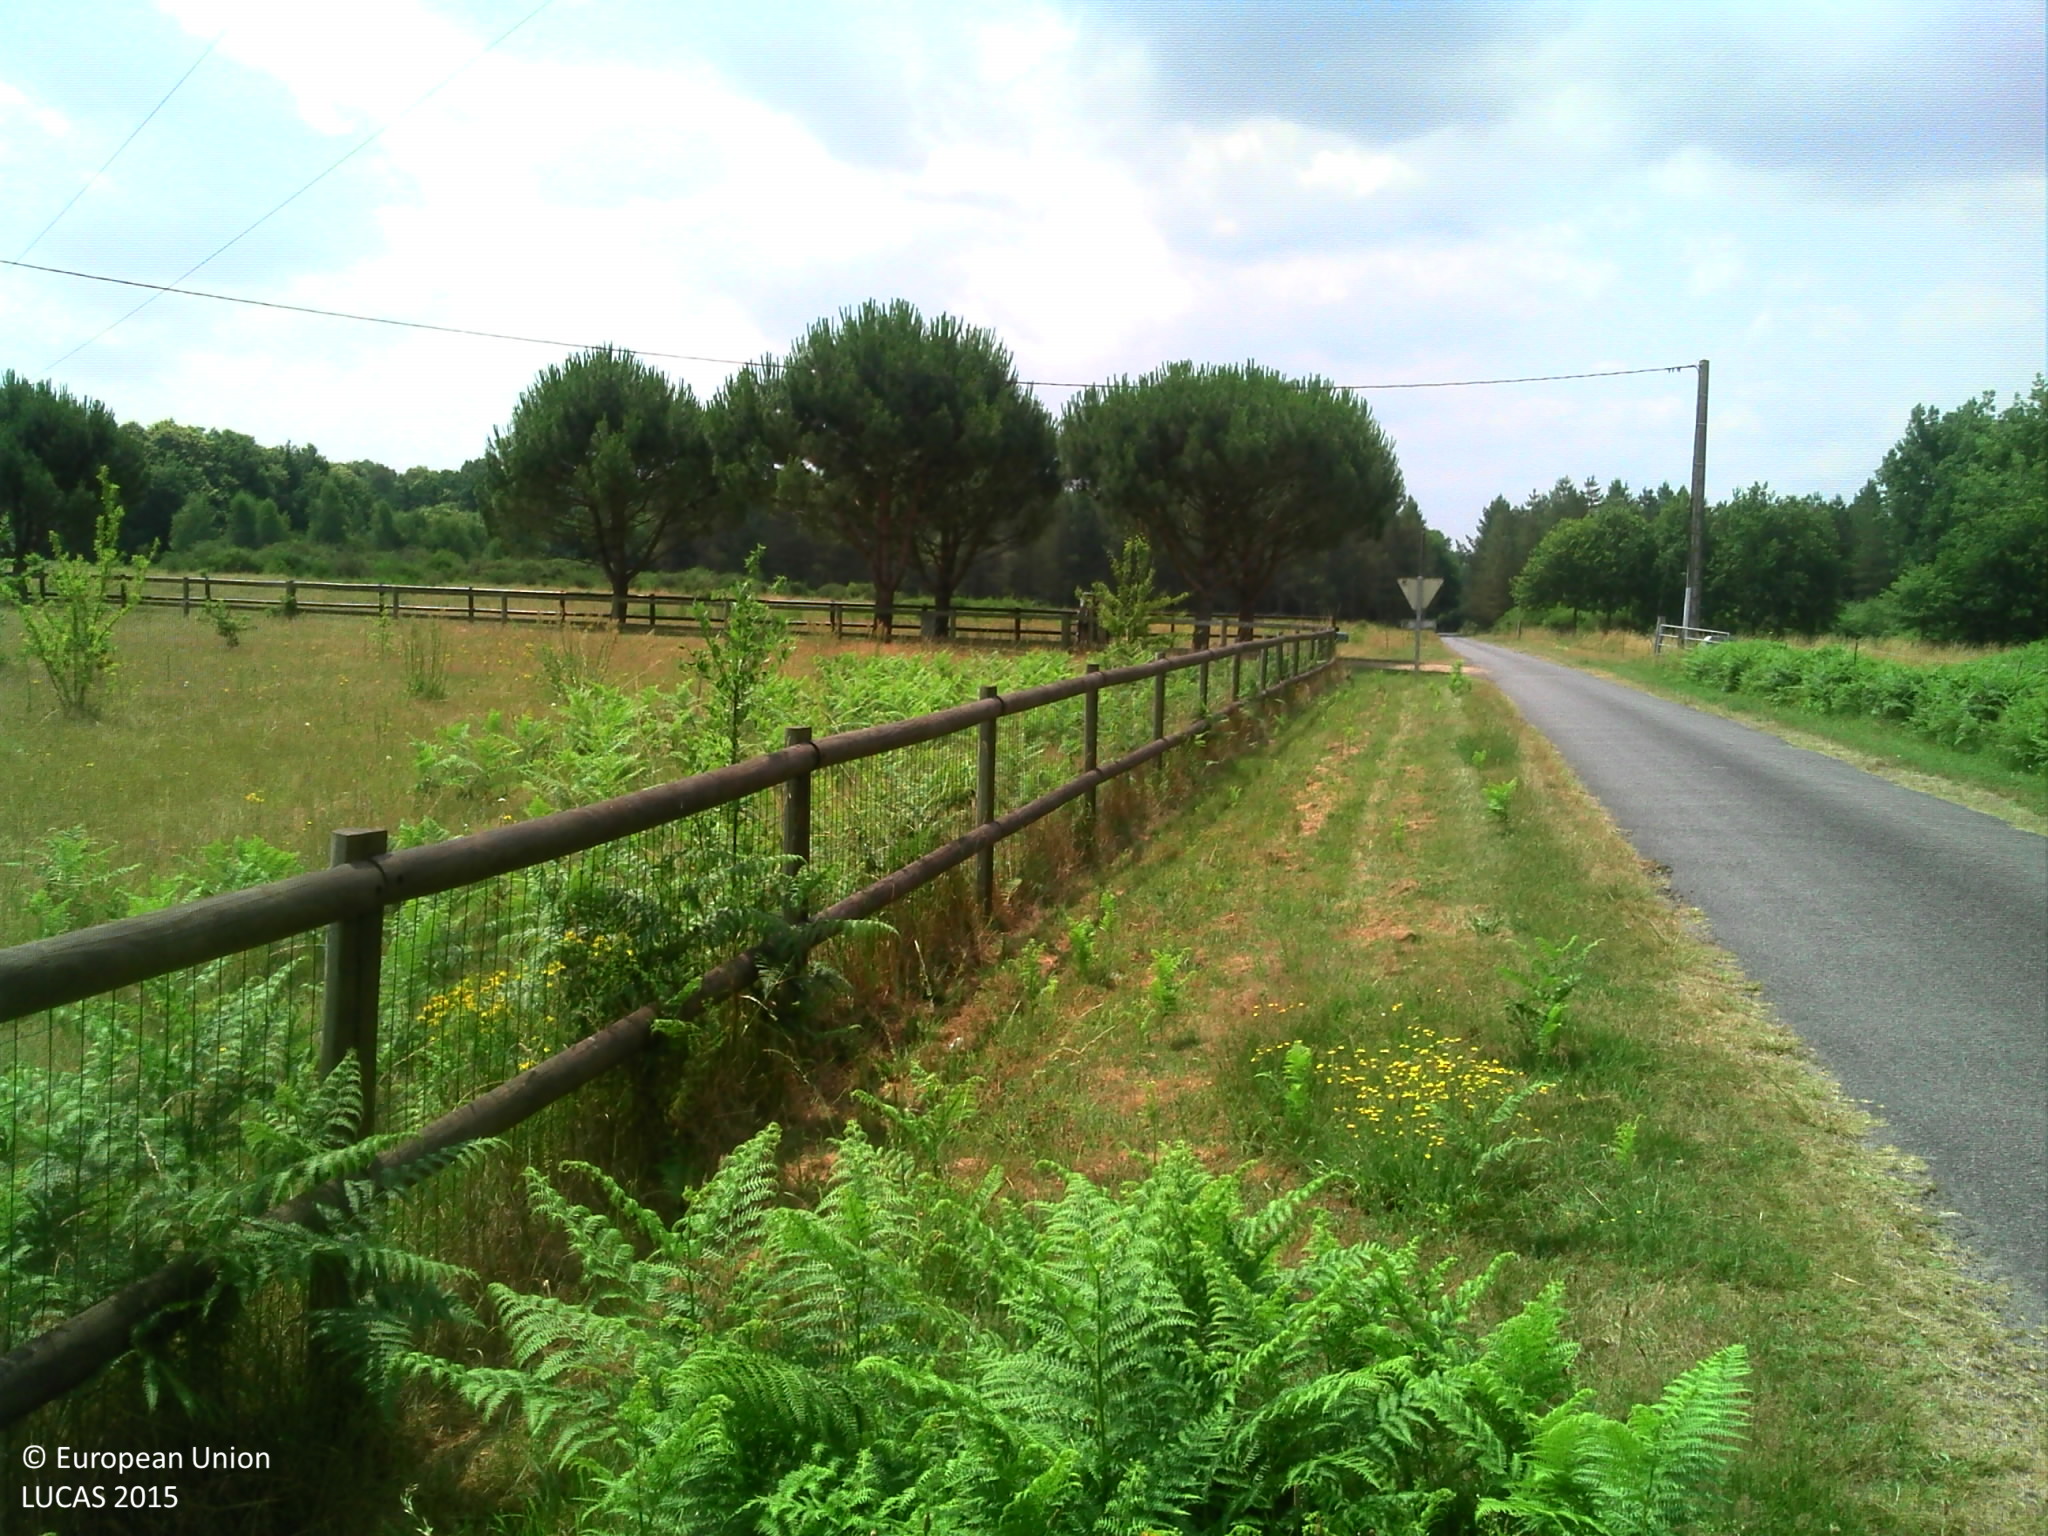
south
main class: Grassland
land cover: Grassland without tree/shrub cover
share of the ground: > 75 %
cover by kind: herbaceous plants 100 %
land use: Agriculture (excluding fallow land and kitchen gardens)
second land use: Residential
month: July
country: FR
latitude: 47.3253
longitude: 0.1184
